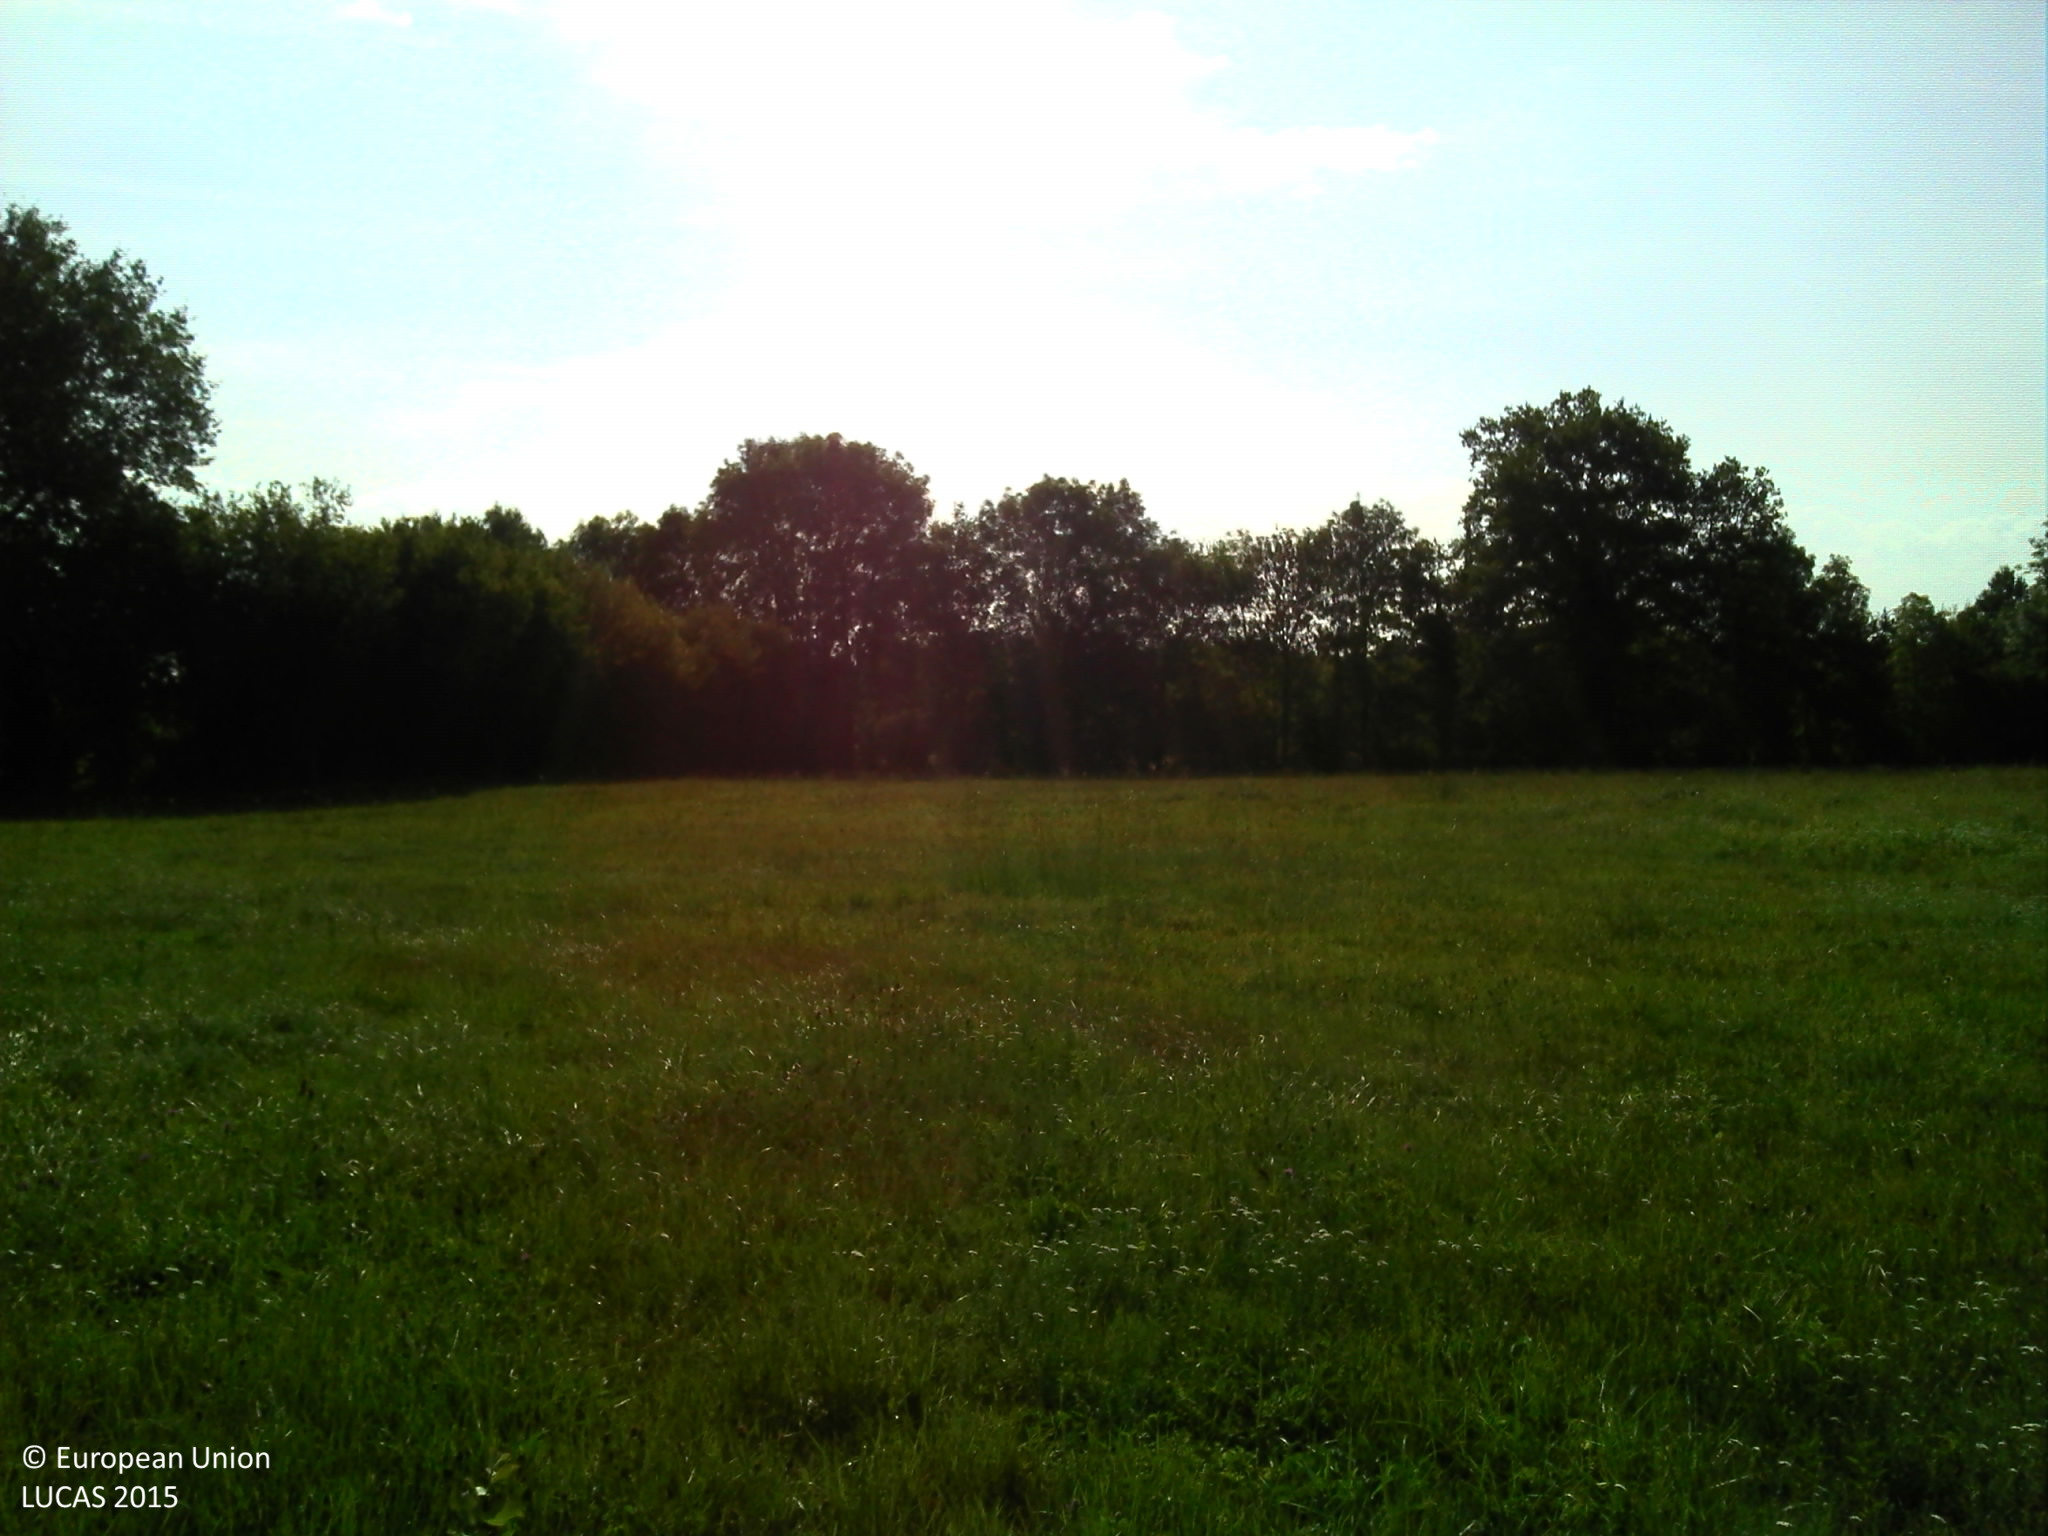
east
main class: Grassland
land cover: Grassland without tree/shrub cover
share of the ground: > 75 %
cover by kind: herbaceous plants 100 %
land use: Agriculture (excluding fallow land and kitchen gardens)
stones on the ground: < 10 %
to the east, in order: Grassland without tree/shrub cover; Fences; Broadleaved woodland; Grassland without tree/shrub cover; Fences; Broadleaved woodland; Rivers and streams; Fences; Grassland without tree/shrub cover
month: August
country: FR
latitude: 46.7060
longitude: 2.8150
